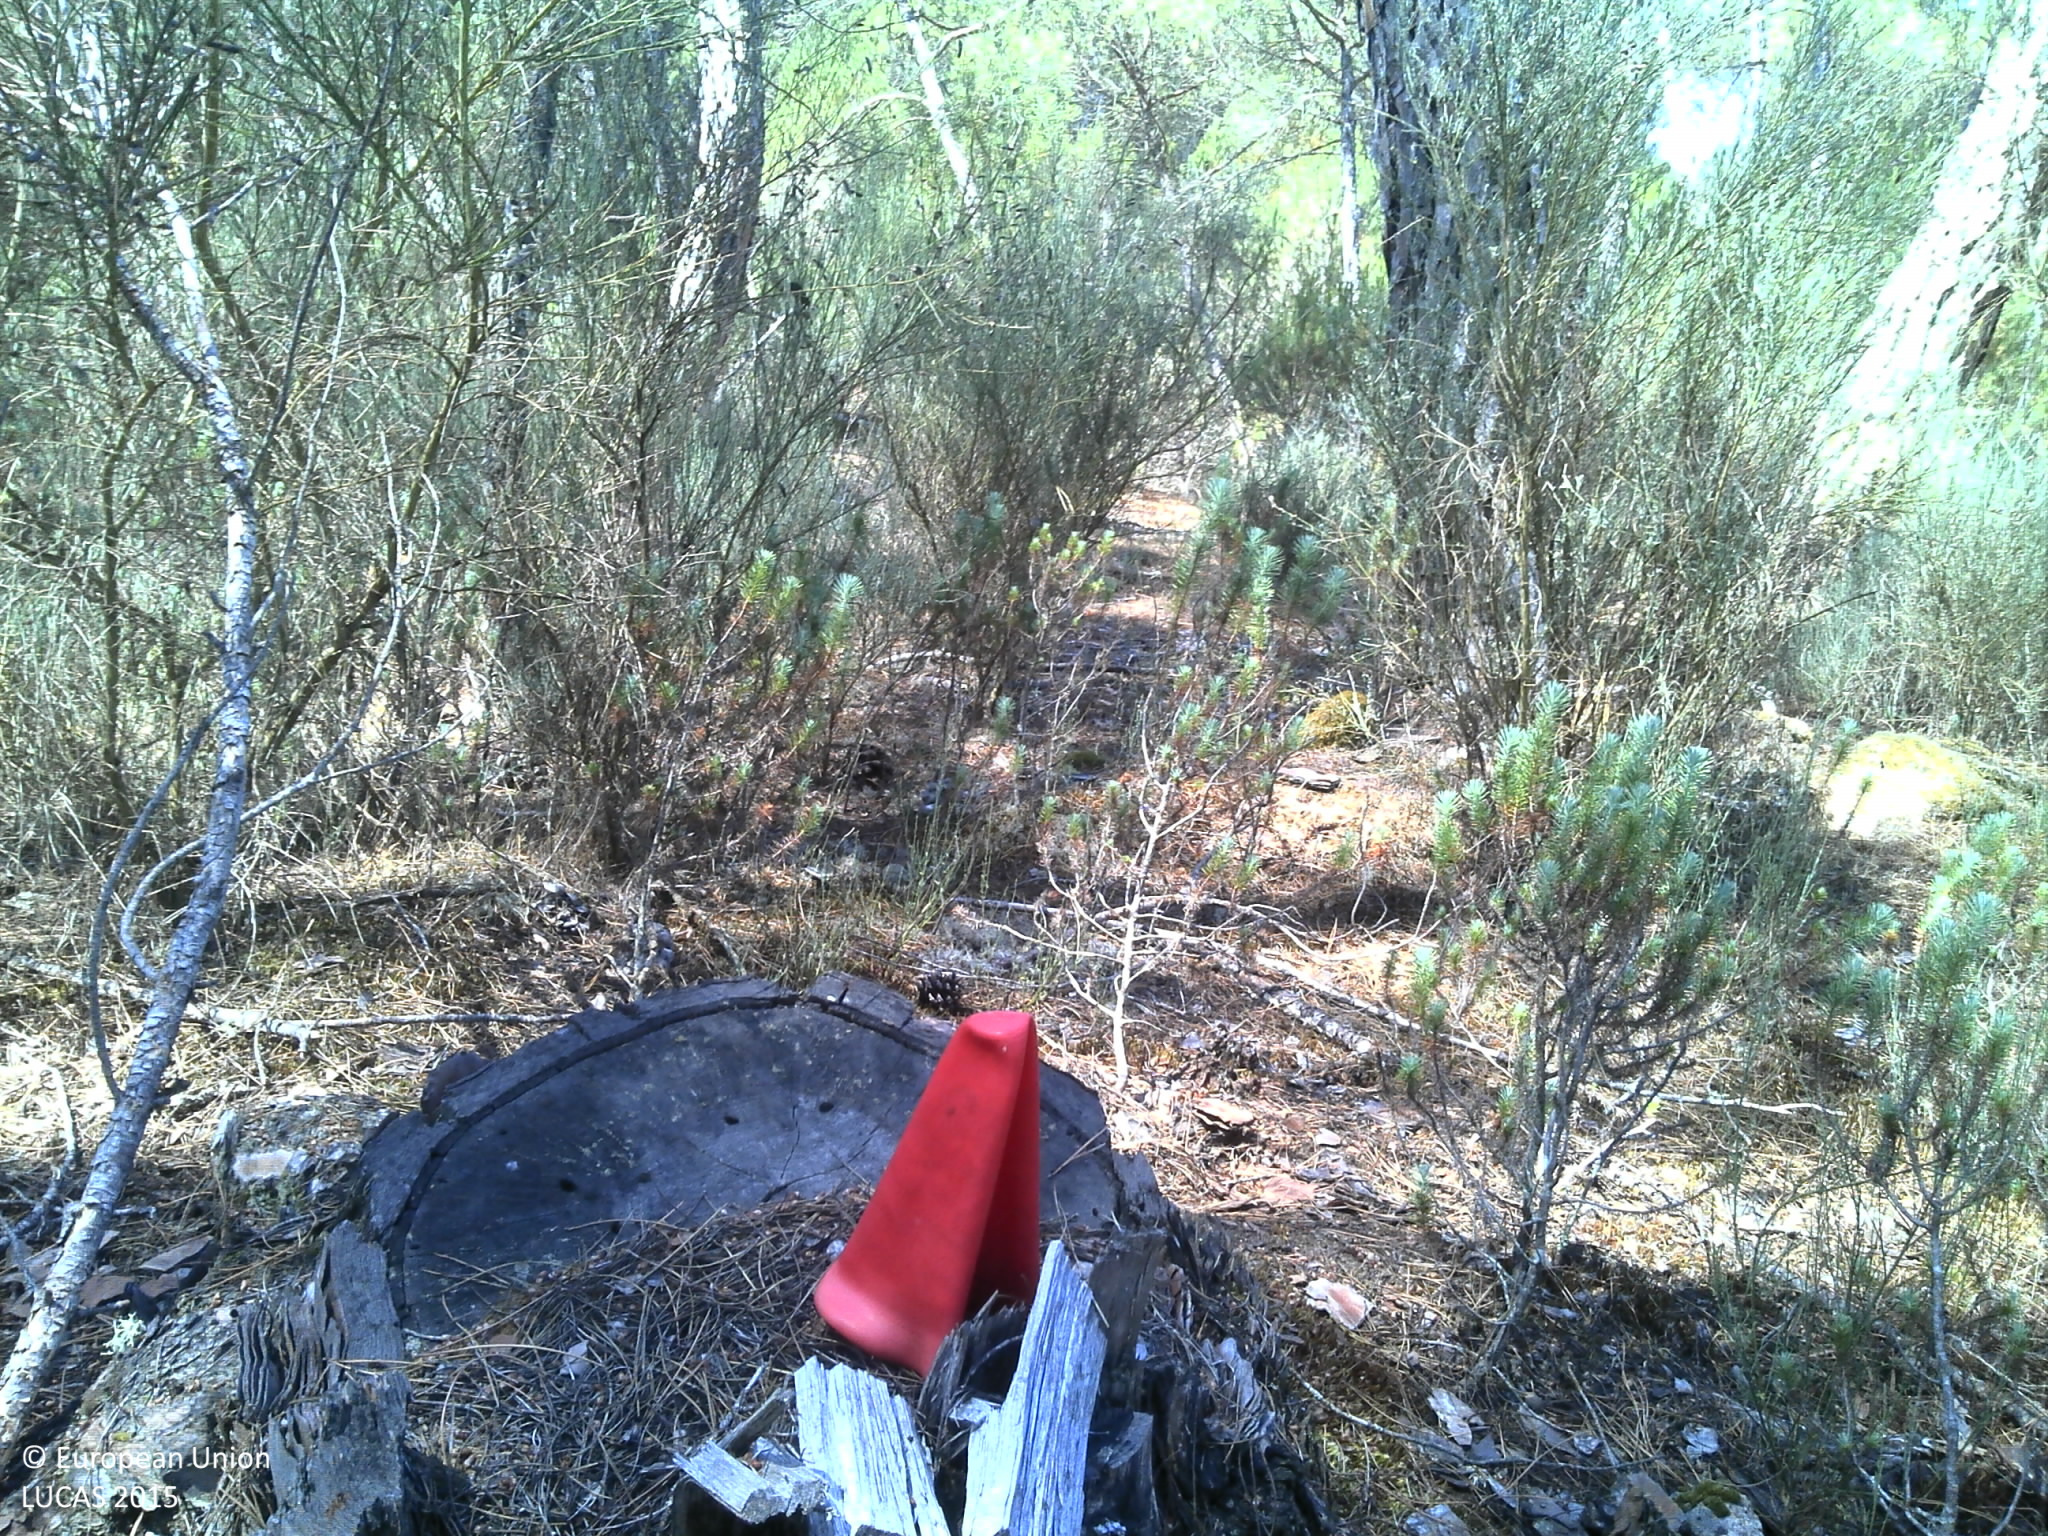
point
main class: Woodland
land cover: Pine dominated coniferous woodland
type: coniferous forest of the mediterranean region
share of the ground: 50 - 75 %
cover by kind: coniferous forest trees 70 %, shrubs 25 %, herbaceous plants 5 %
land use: Forestry
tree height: > 5 m
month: June
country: PT
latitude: 40.5729
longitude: -7.8520
